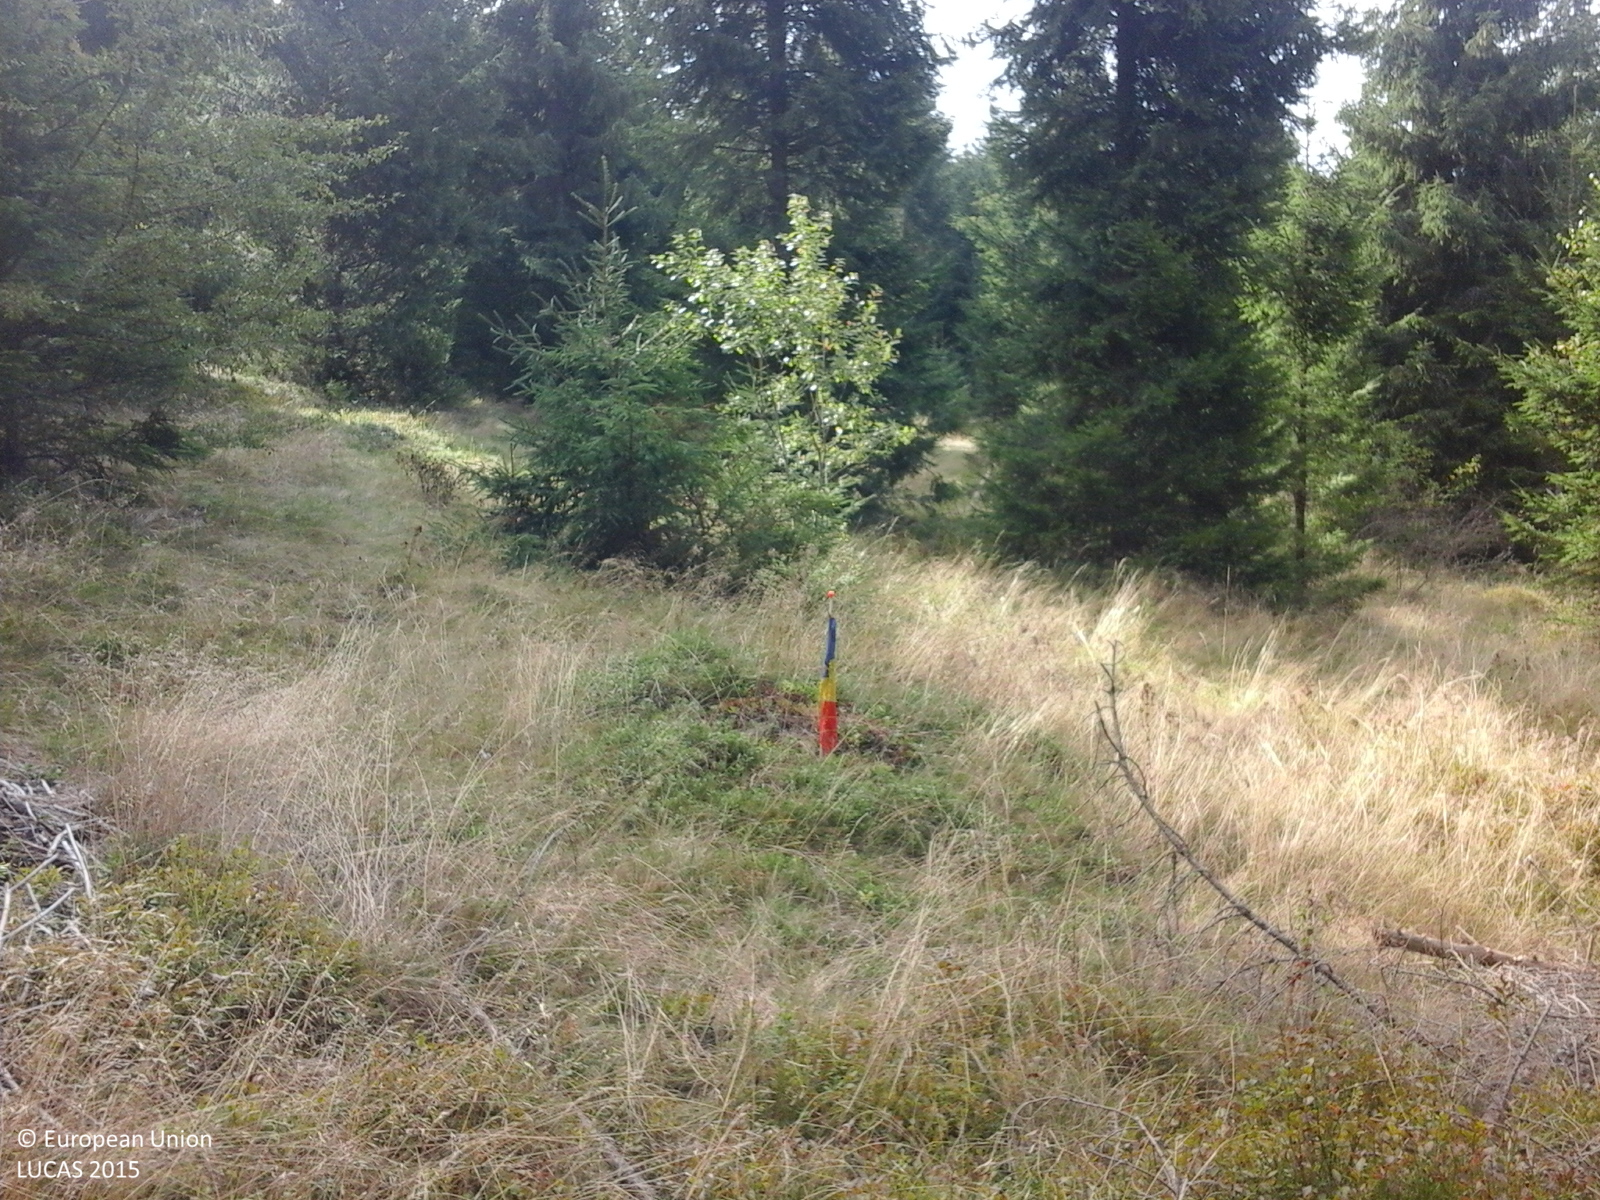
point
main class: Woodland
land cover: Spruce dominated coniferous woodland
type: alpine coniferous forest
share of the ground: > 75 %
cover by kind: coniferous forest trees 75 %, herbaceous plants 15 %, broadleaved forest trees 10 %
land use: Forestry
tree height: > 5 m
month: September
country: RO
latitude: 46.6936
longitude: 23.0729
